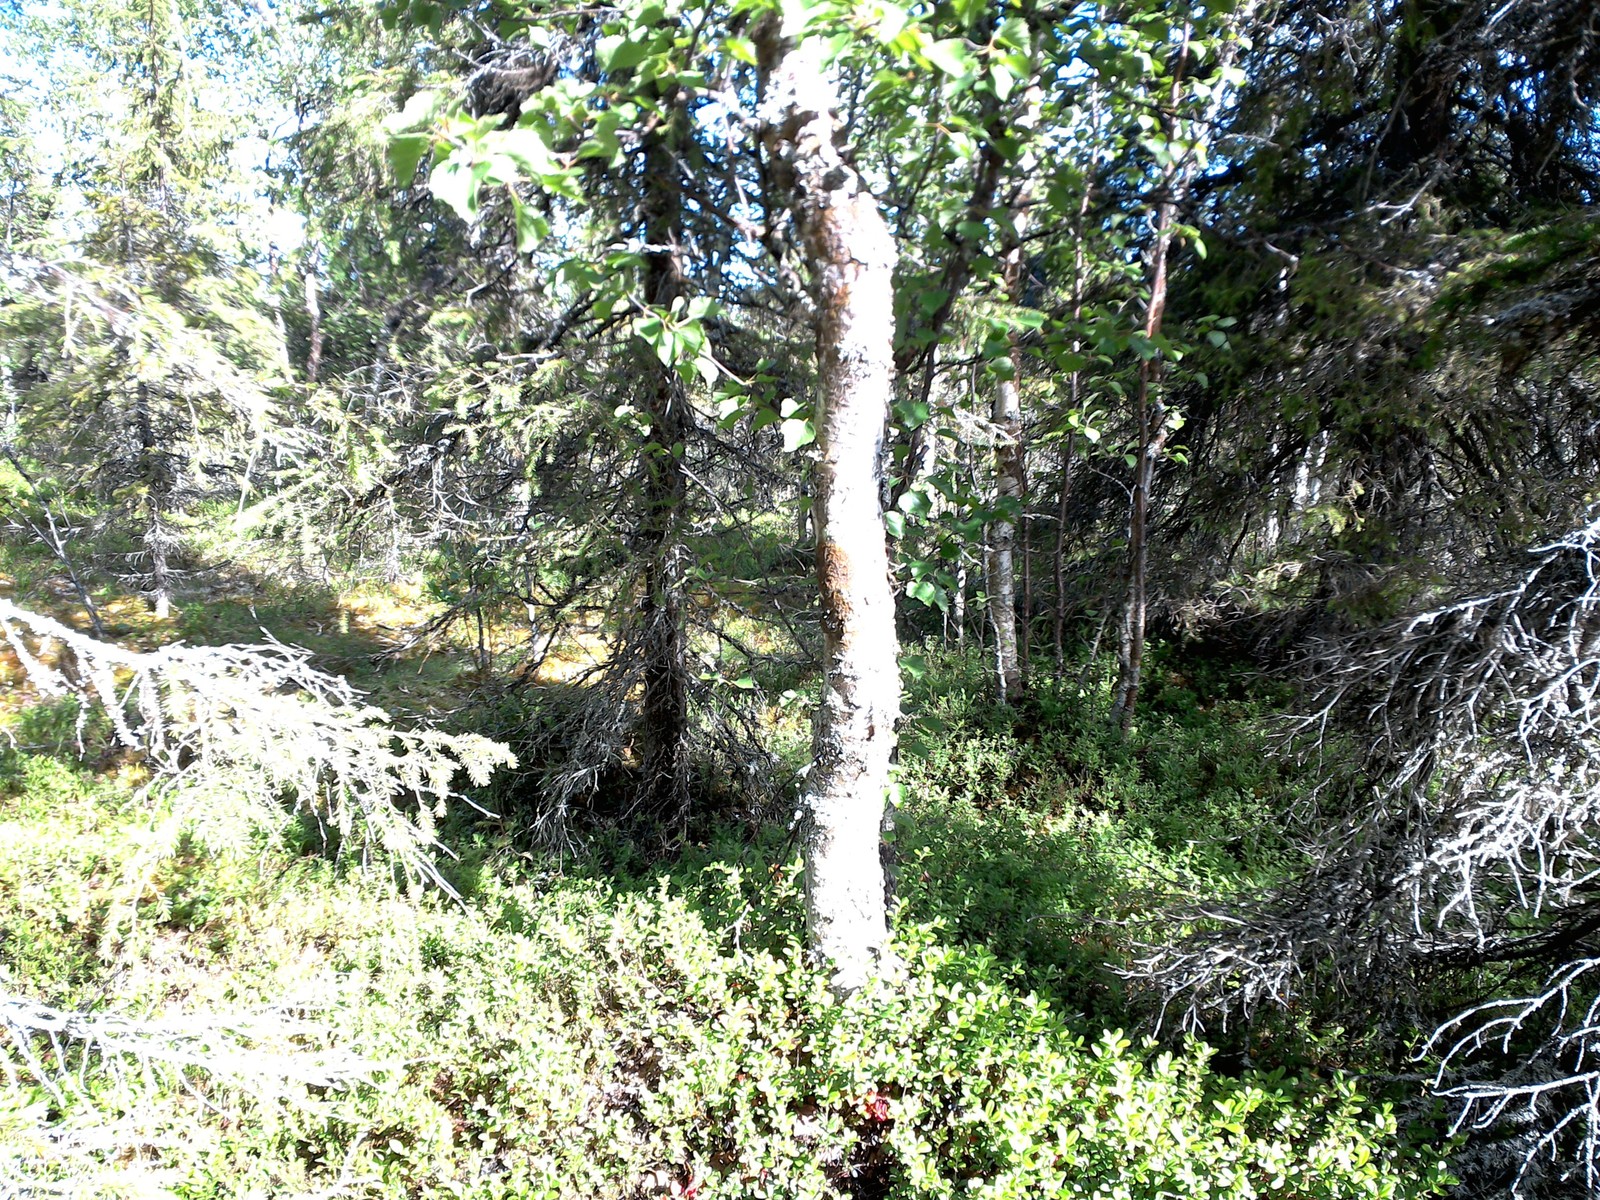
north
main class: Woodland
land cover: Spruce dominated mixed woodland
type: boreal forest
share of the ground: 25 - 50 %
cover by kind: shrubs 50 %, coniferous forest trees 25 %, broadleaved forest trees 15 %, lichens and mosses 10 %
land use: Forestry
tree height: > 5 m
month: July
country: SE
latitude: 67.6216
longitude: 21.2678
